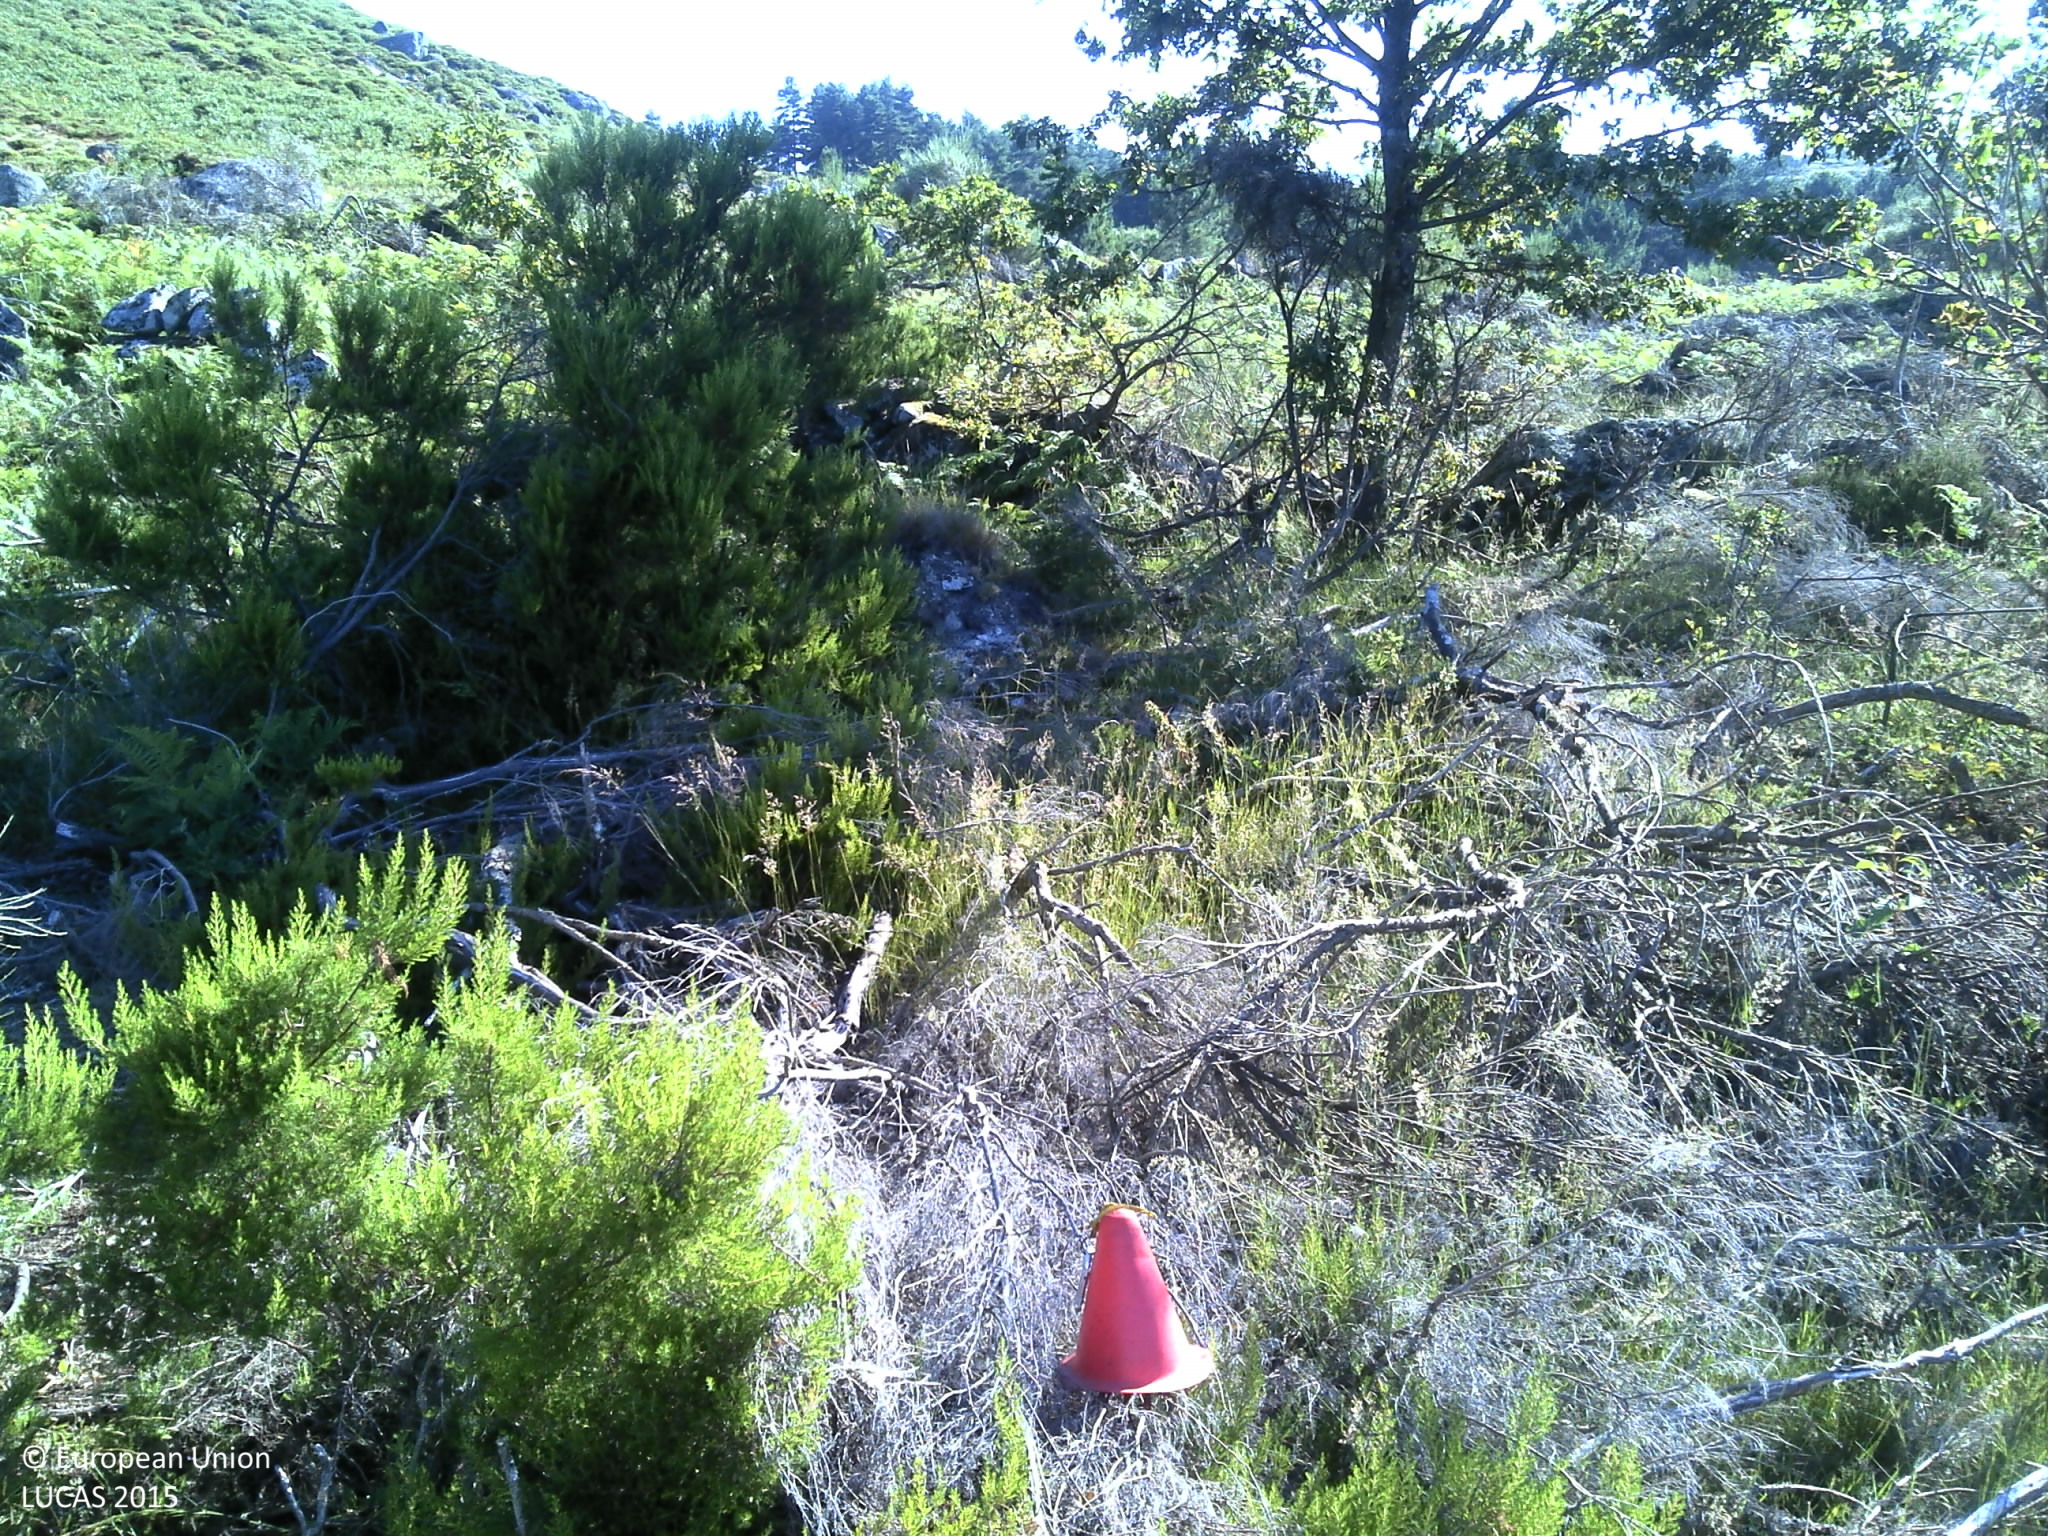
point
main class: Shrubland
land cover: Shrubland with sparse tree cover
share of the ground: > 75 %
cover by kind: shrubs 80 %, herbaceous plants 10 %, broadleaved forest trees 5 %, unconsolidated bare surface 5 %
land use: Agriculture (excluding fallow land and kitchen gardens)
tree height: < 5 m
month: July
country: PT
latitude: 41.4254
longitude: -7.8323
